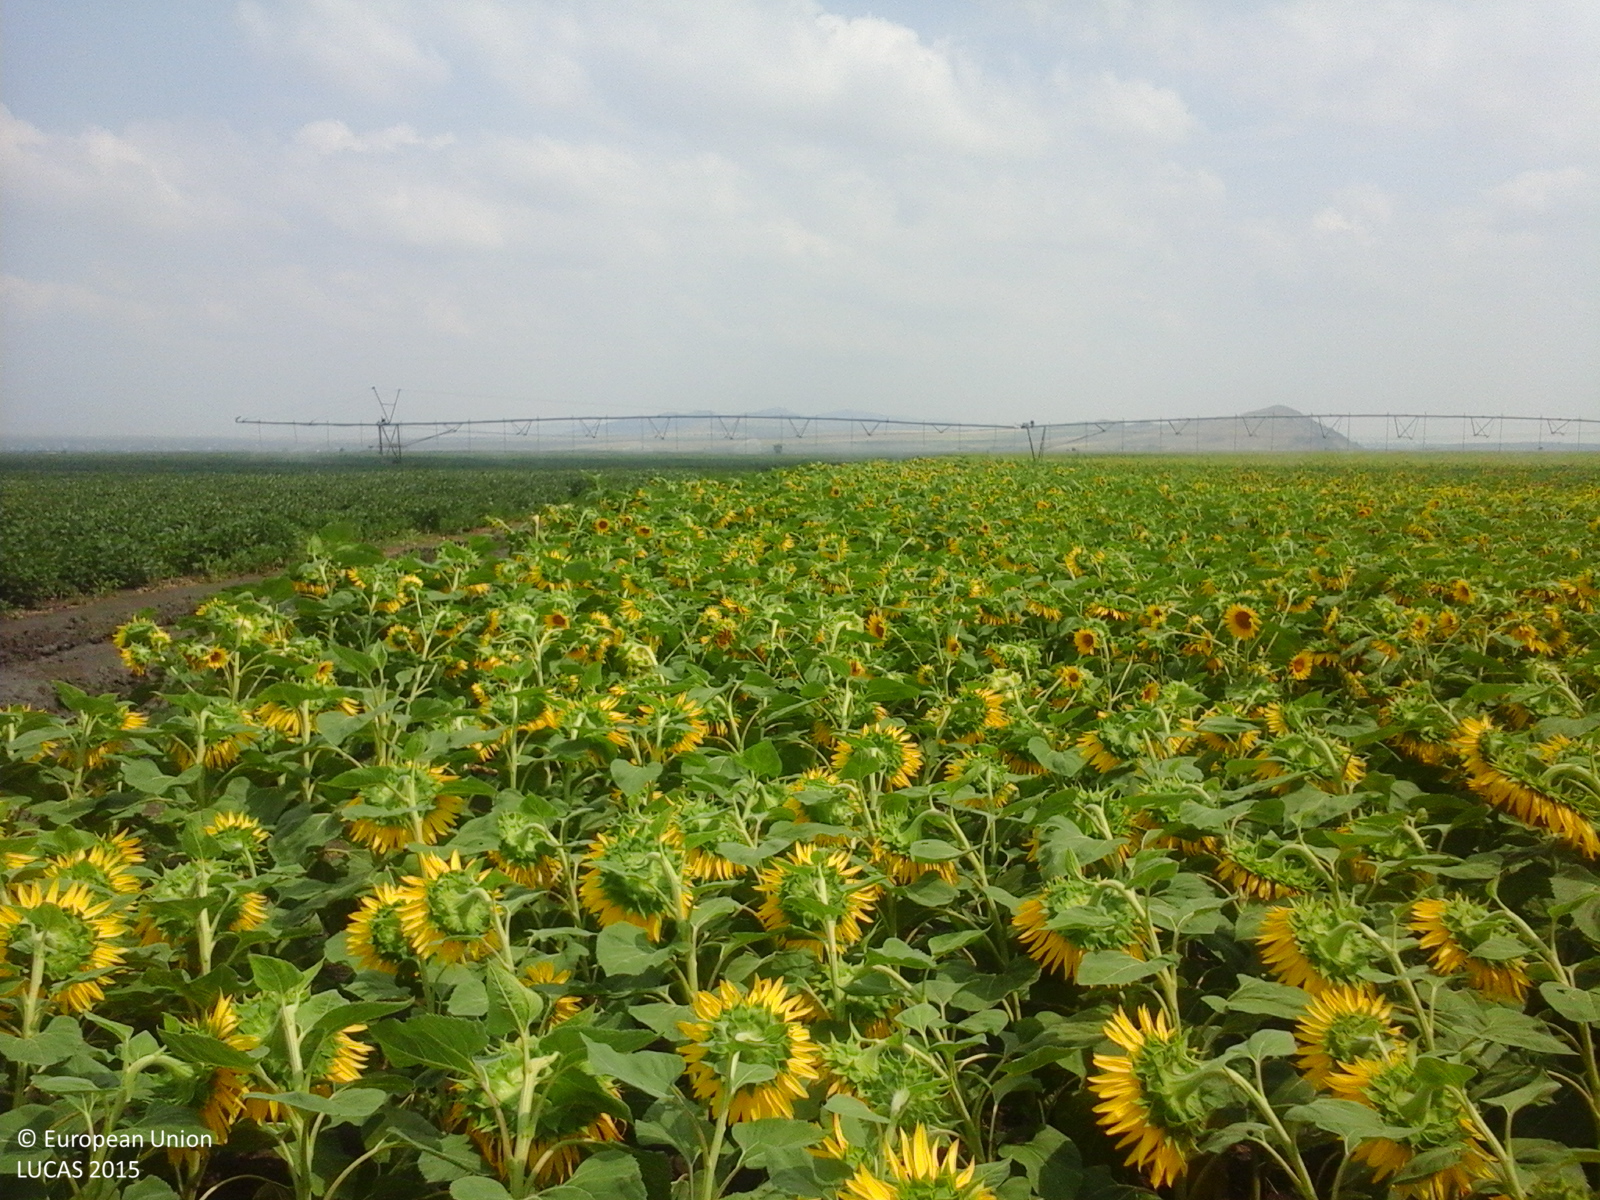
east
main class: Cropland
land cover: Sunflower
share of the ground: > 75 %
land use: Agriculture (excluding fallow land and kitchen gardens)
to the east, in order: Sunflower; Tracks; Soya
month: July
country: RO
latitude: 45.3127
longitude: 28.0648
